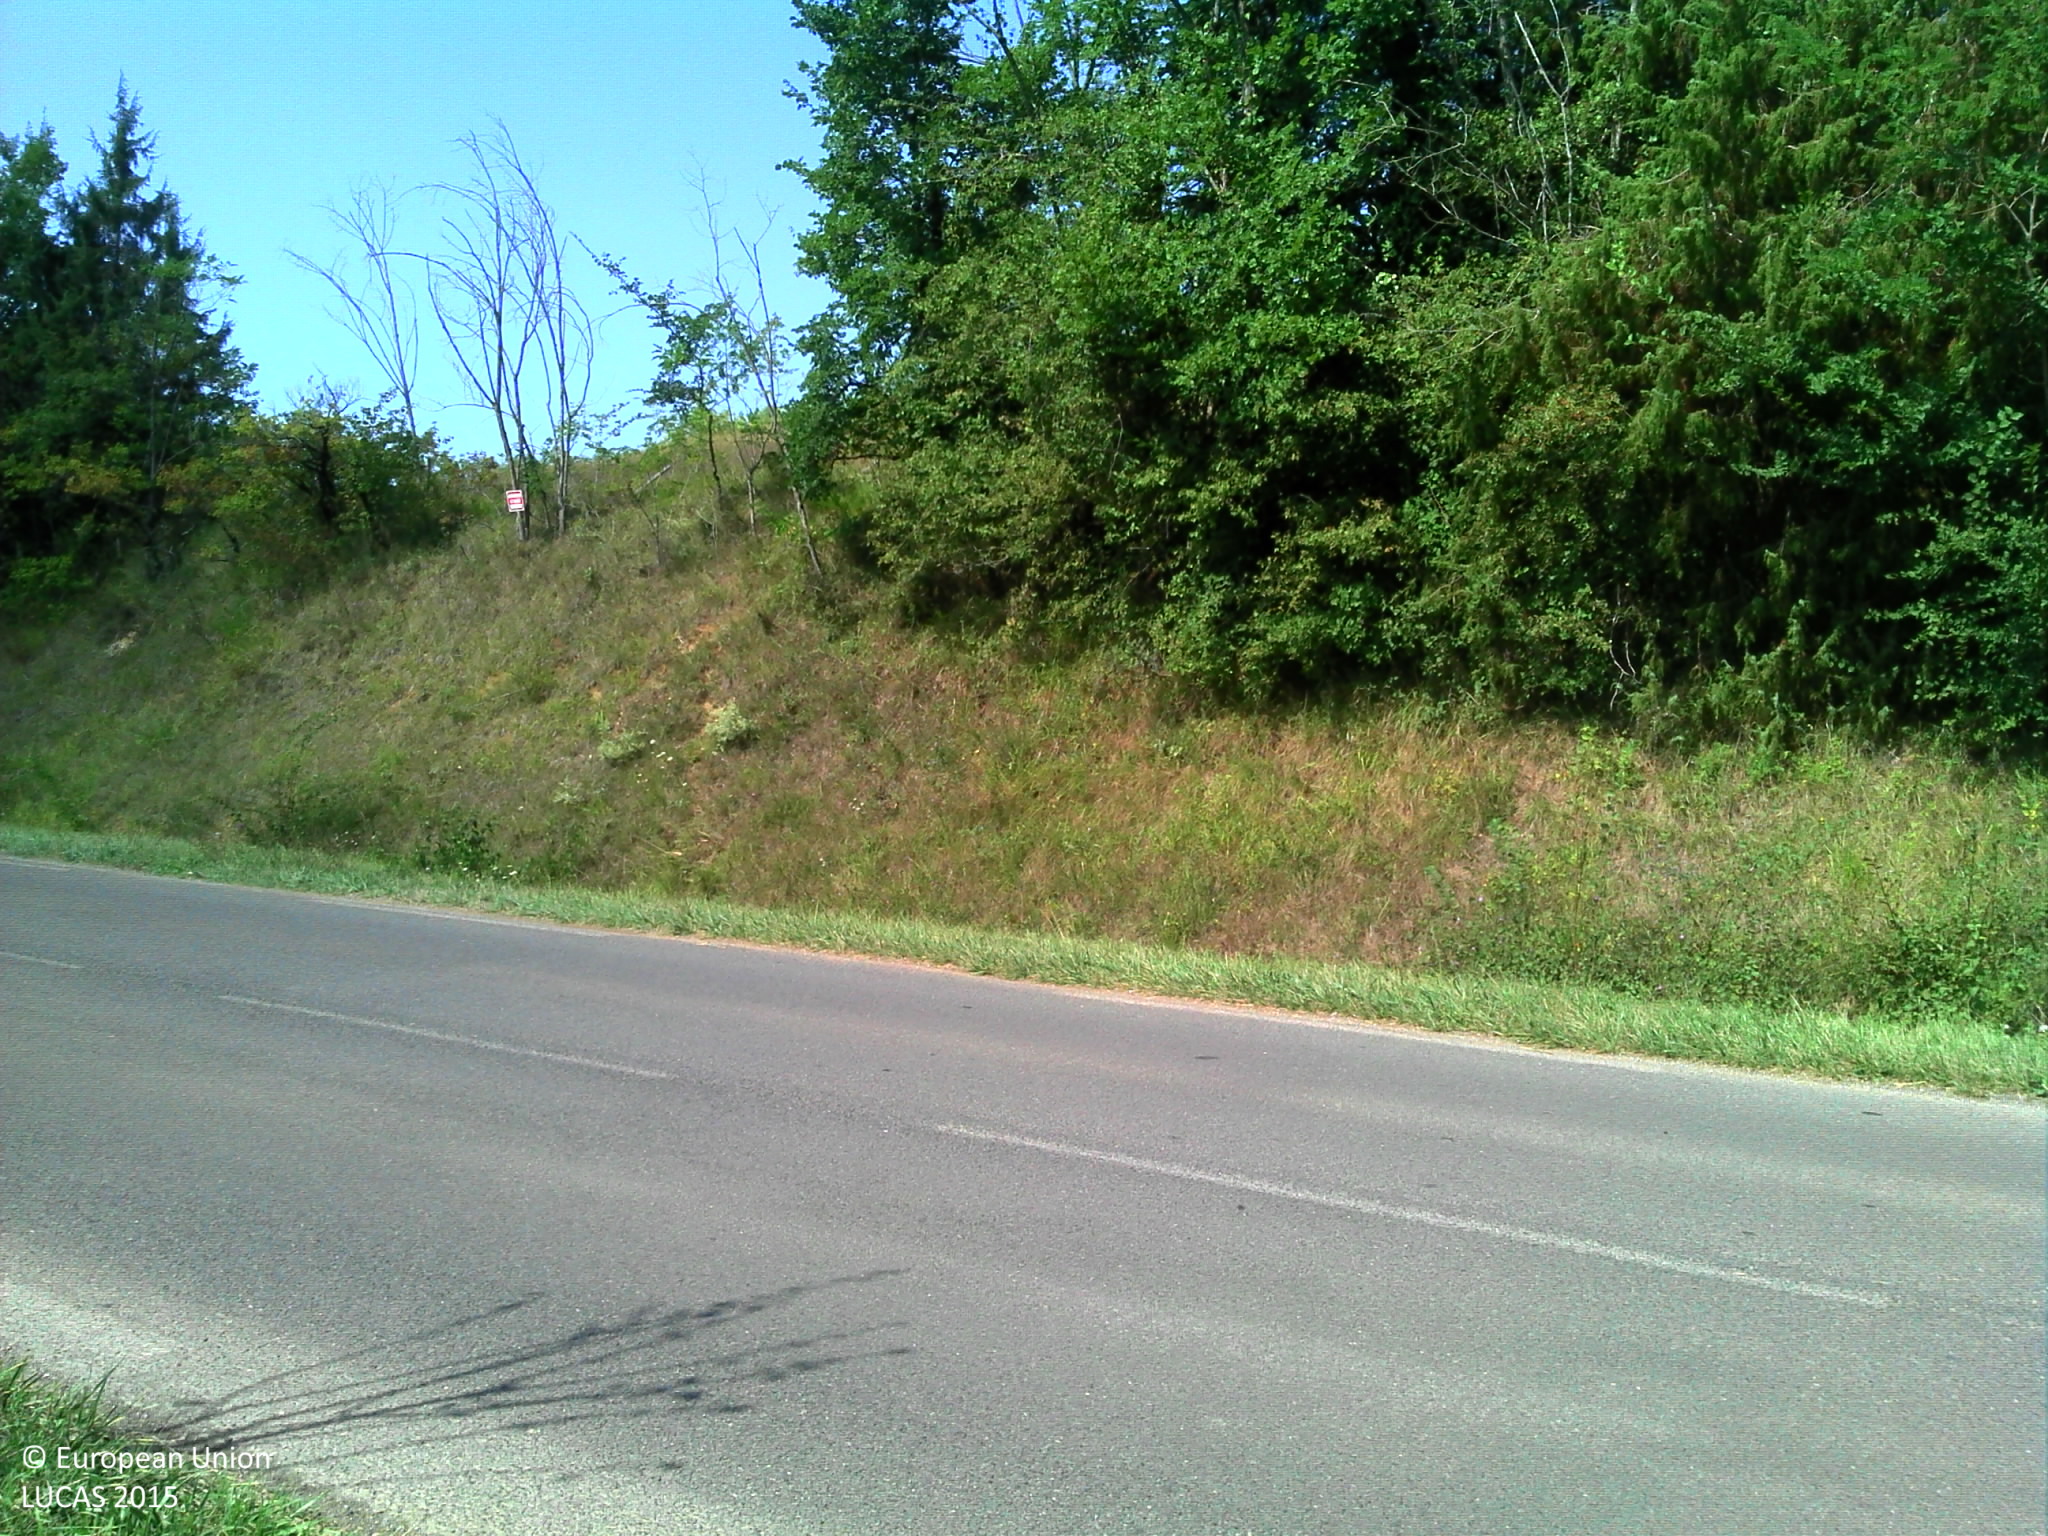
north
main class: Cropland
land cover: Maize
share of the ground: > 75 %
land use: Agriculture (excluding fallow land and kitchen gardens)
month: August
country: FR
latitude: 45.2787
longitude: 0.7477
